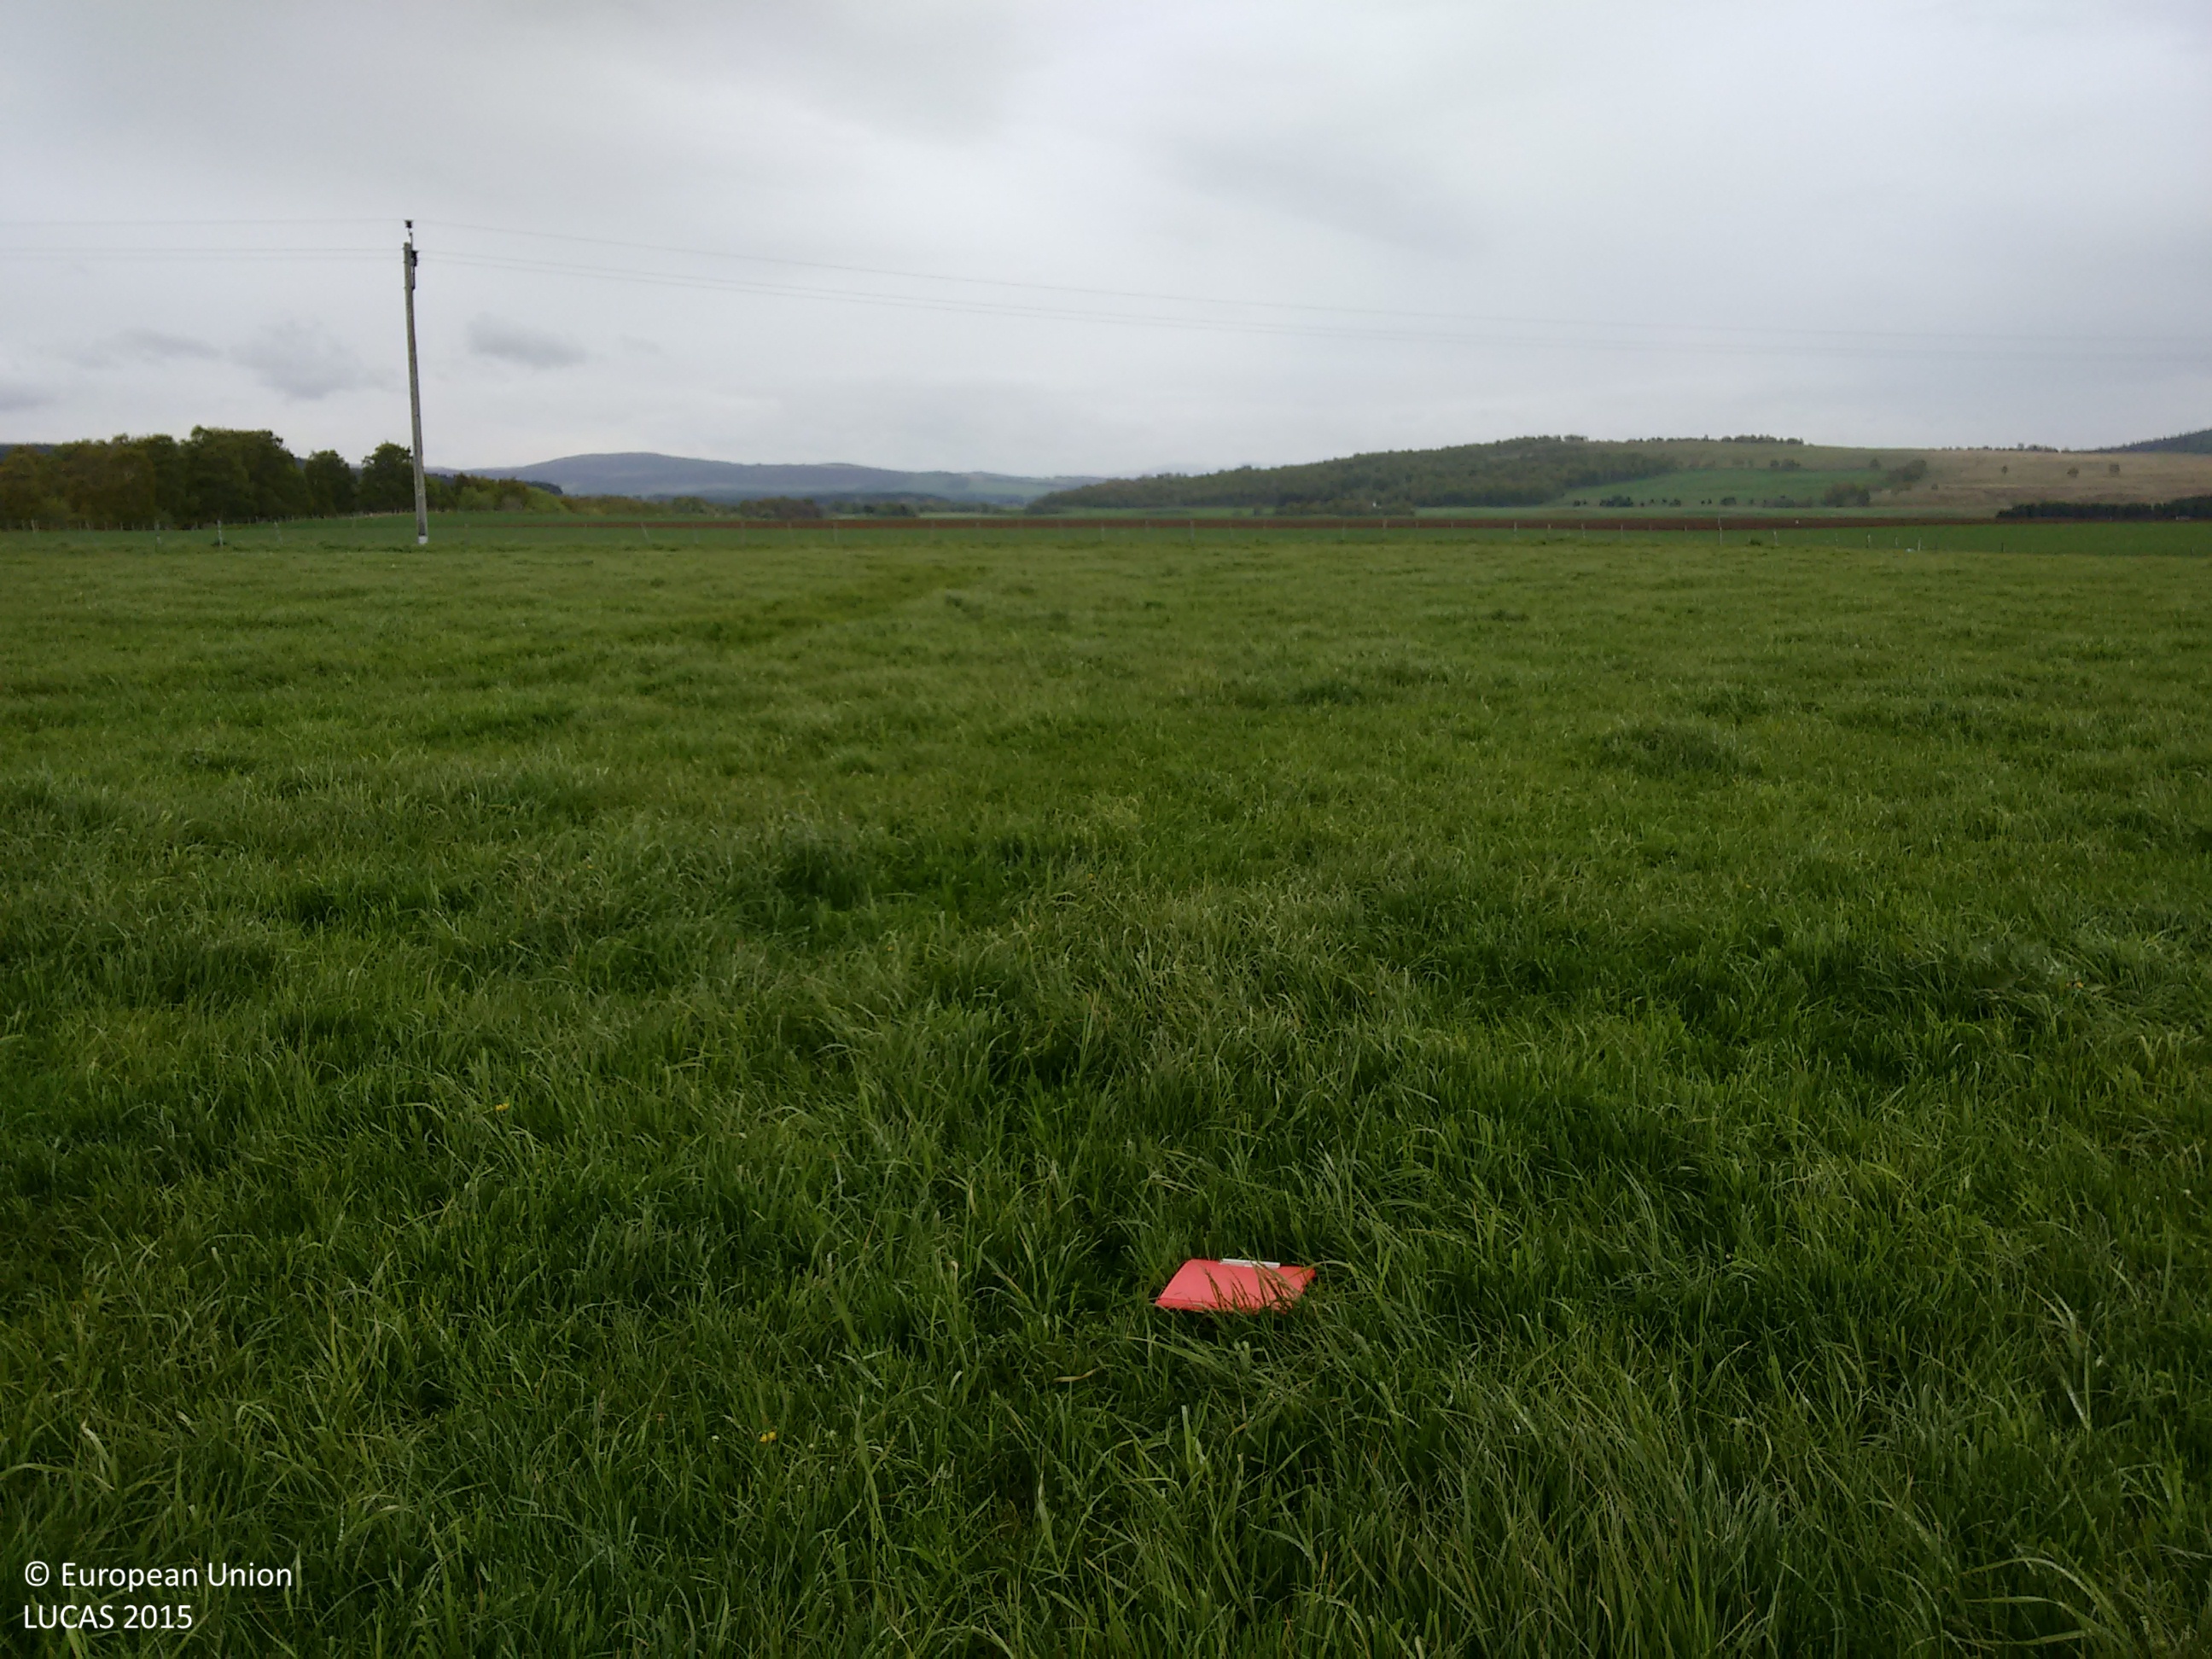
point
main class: Grassland
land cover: Grassland without tree/shrub cover
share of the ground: > 75 %
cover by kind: herbaceous plants 100 %
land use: Agriculture (excluding fallow land and kitchen gardens)
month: June
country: GB
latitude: 57.2837
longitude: -3.7965
